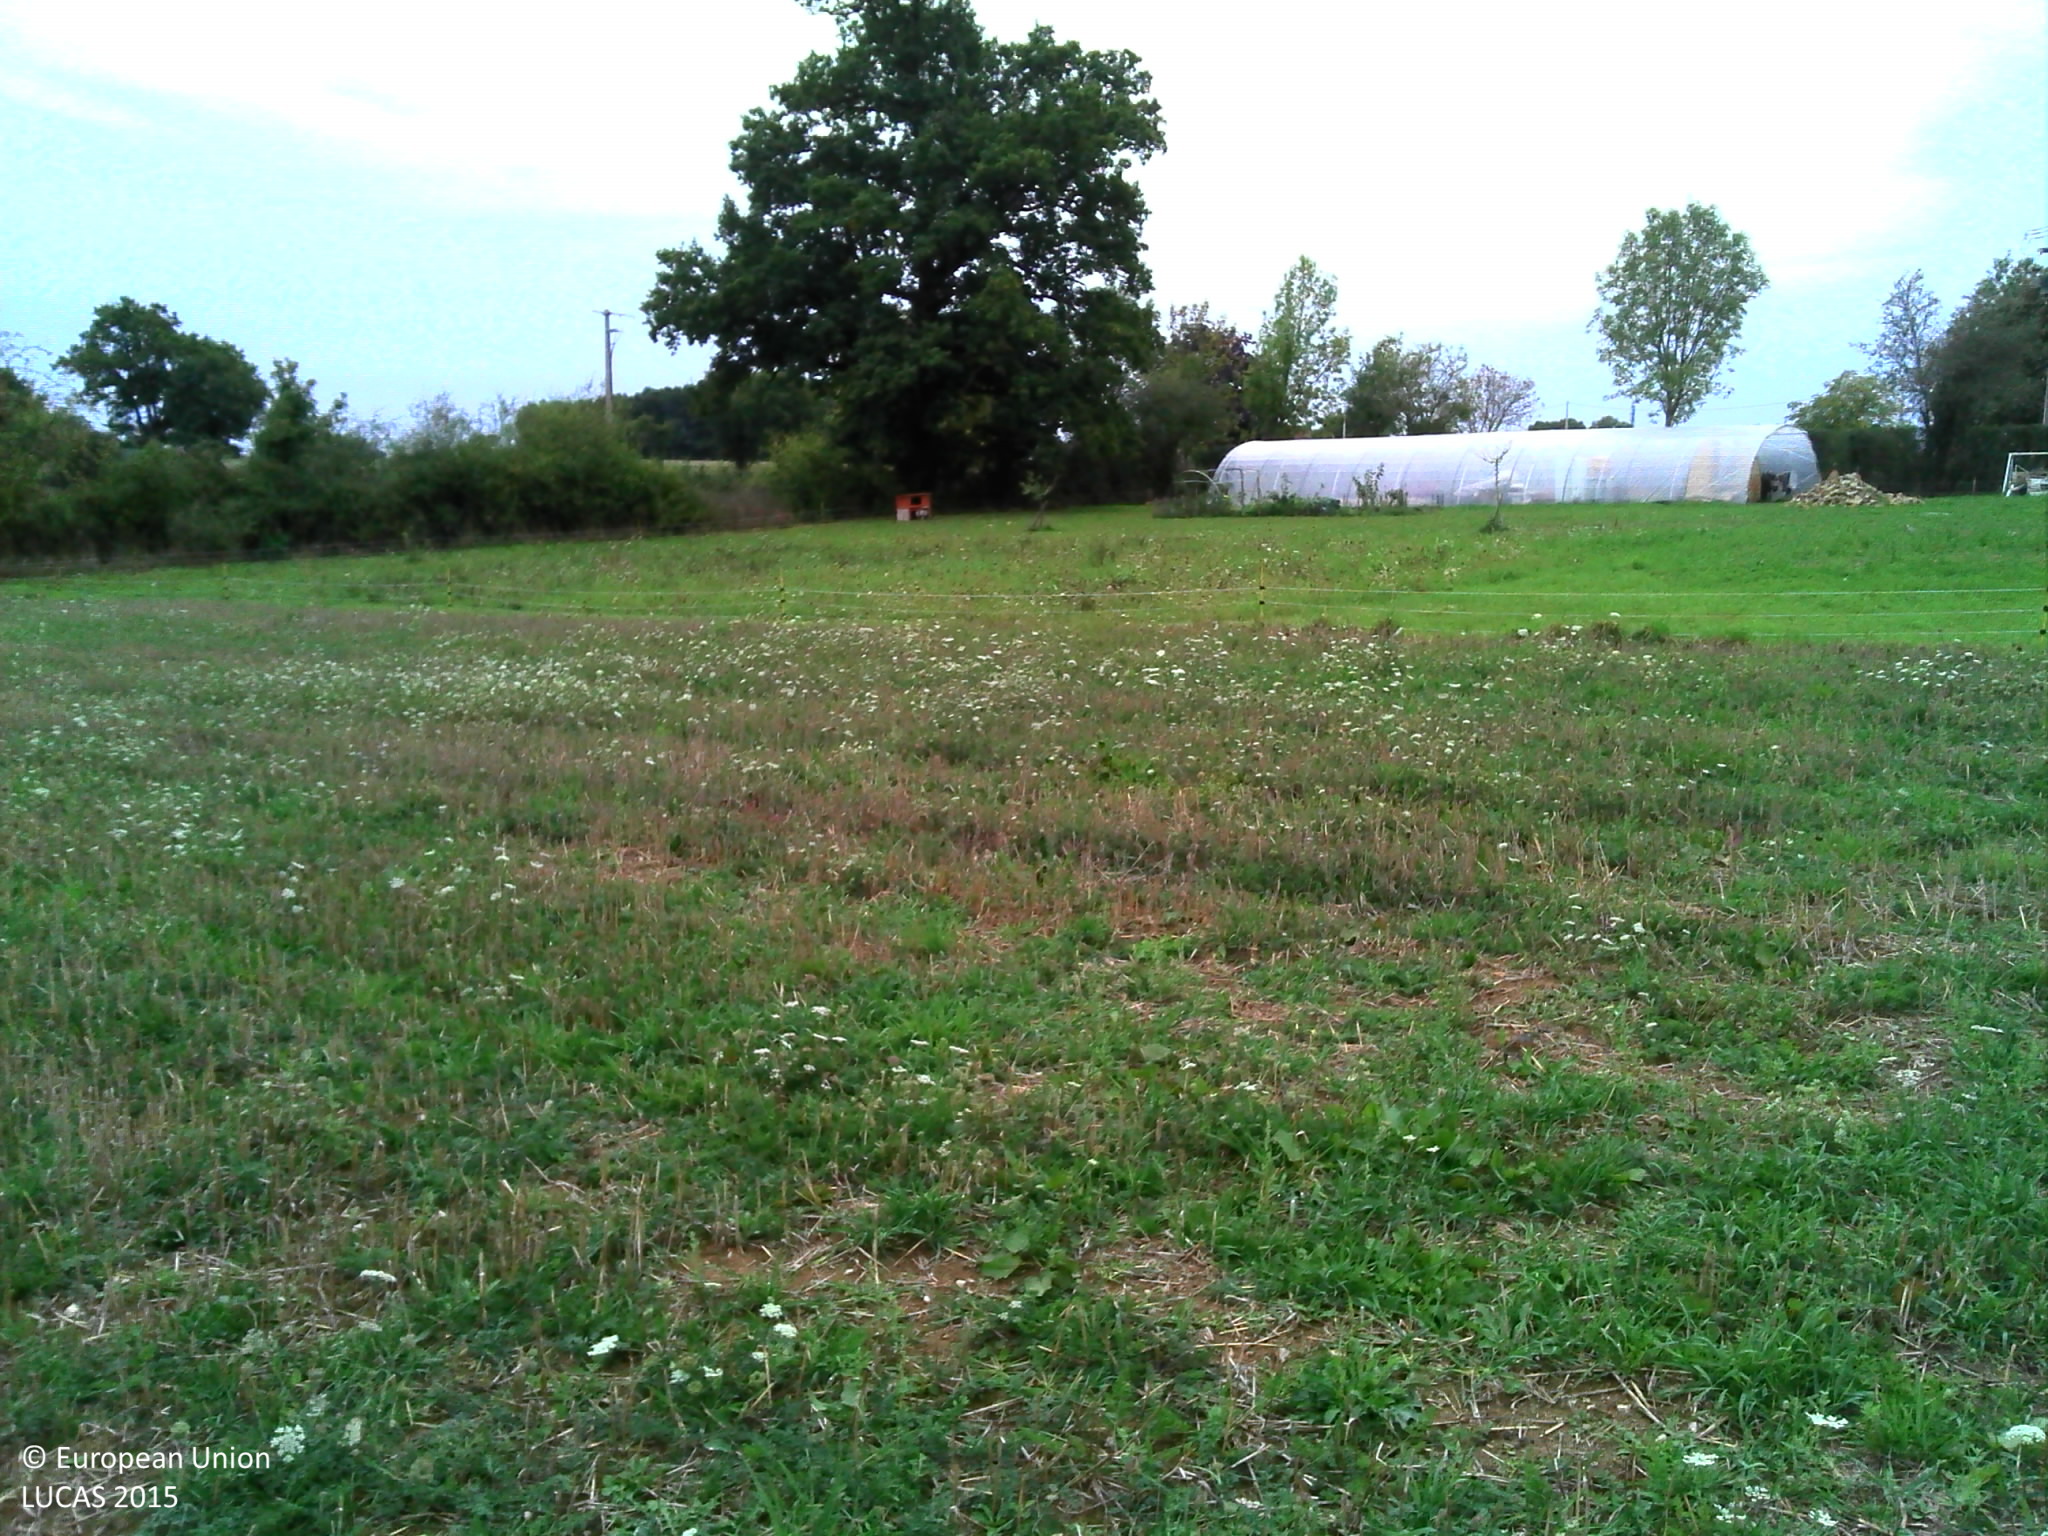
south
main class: Grassland
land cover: Spontaneously vegetated surfaces
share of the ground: 25 - 50 %
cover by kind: herbaceous plants 60 %, unconsolidated bare surface 40 %
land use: Agriculture (excluding fallow land and kitchen gardens)
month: September
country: FR
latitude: 46.5100
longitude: 1.6103
